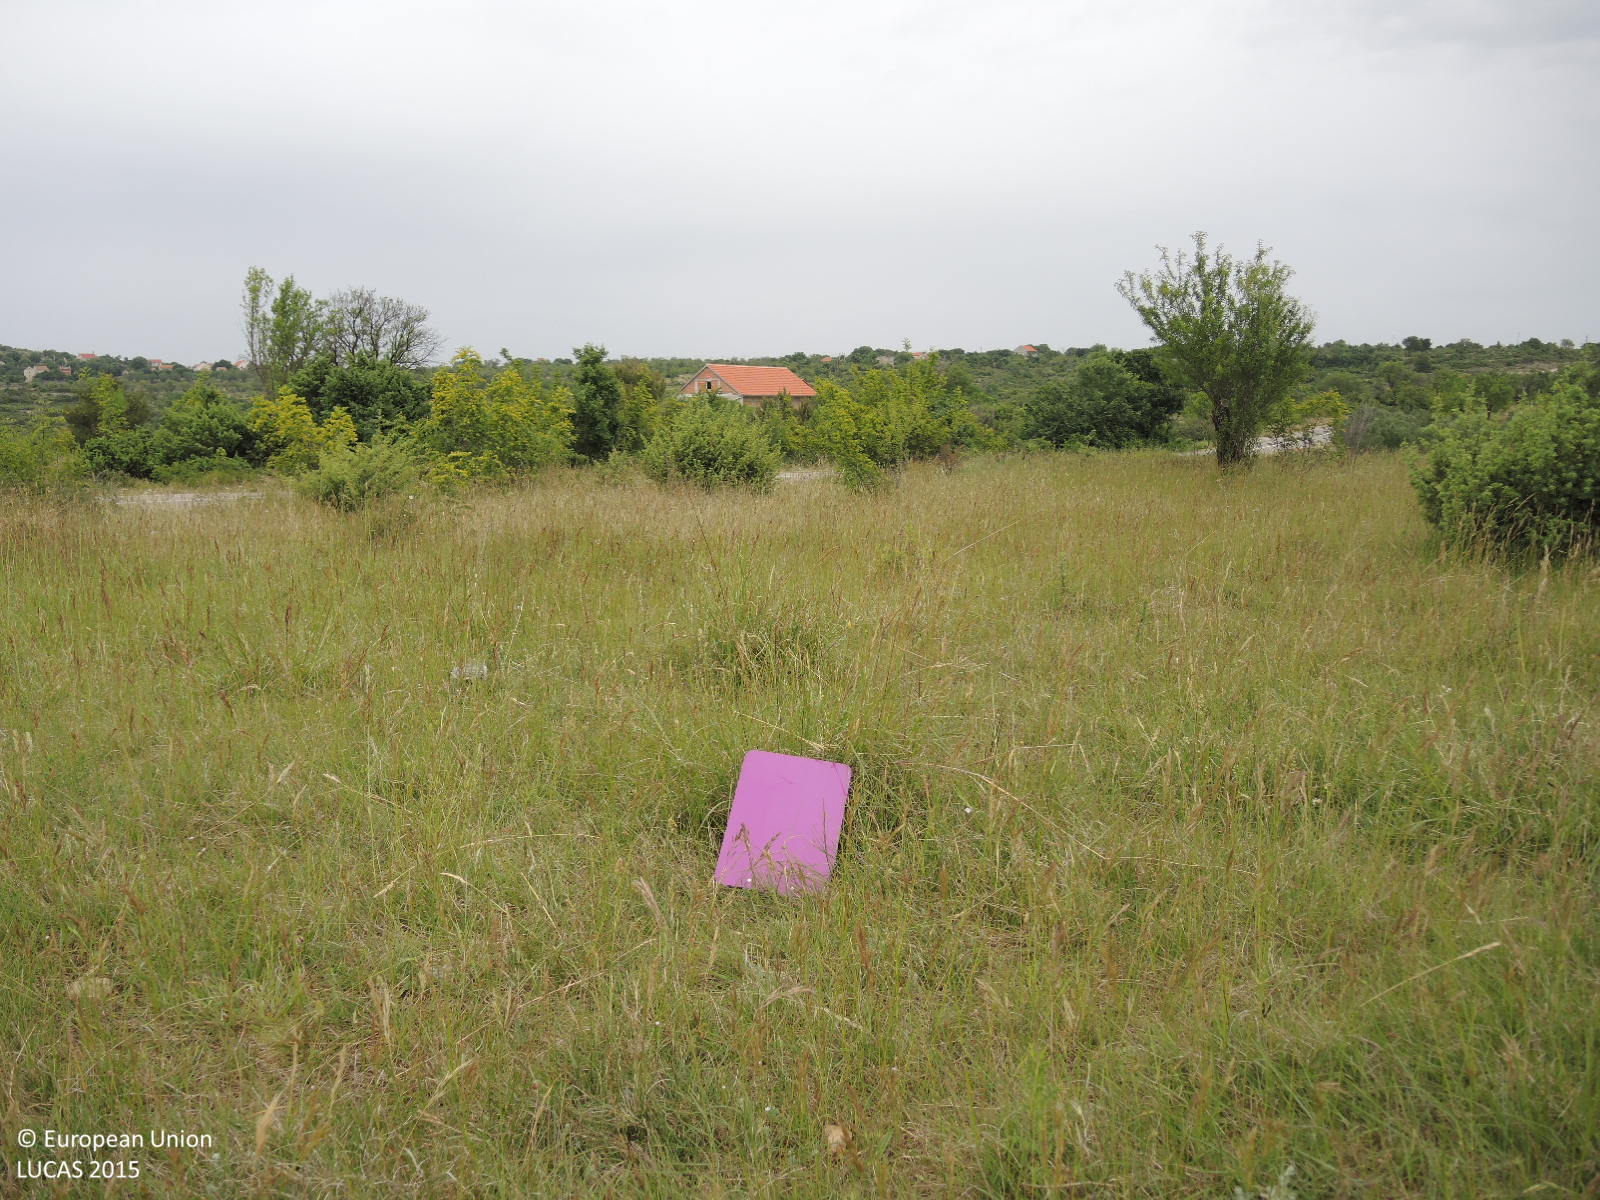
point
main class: Shrubland
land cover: Shrubland without tree cover
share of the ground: 10 - 25 %
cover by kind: herbaceous plants 65 %, shrubs 25 %, unconsolidated bare surface 10 %
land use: Semi-natural and natural areas not in use
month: May
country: HR
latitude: 43.9153
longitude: 15.8322
